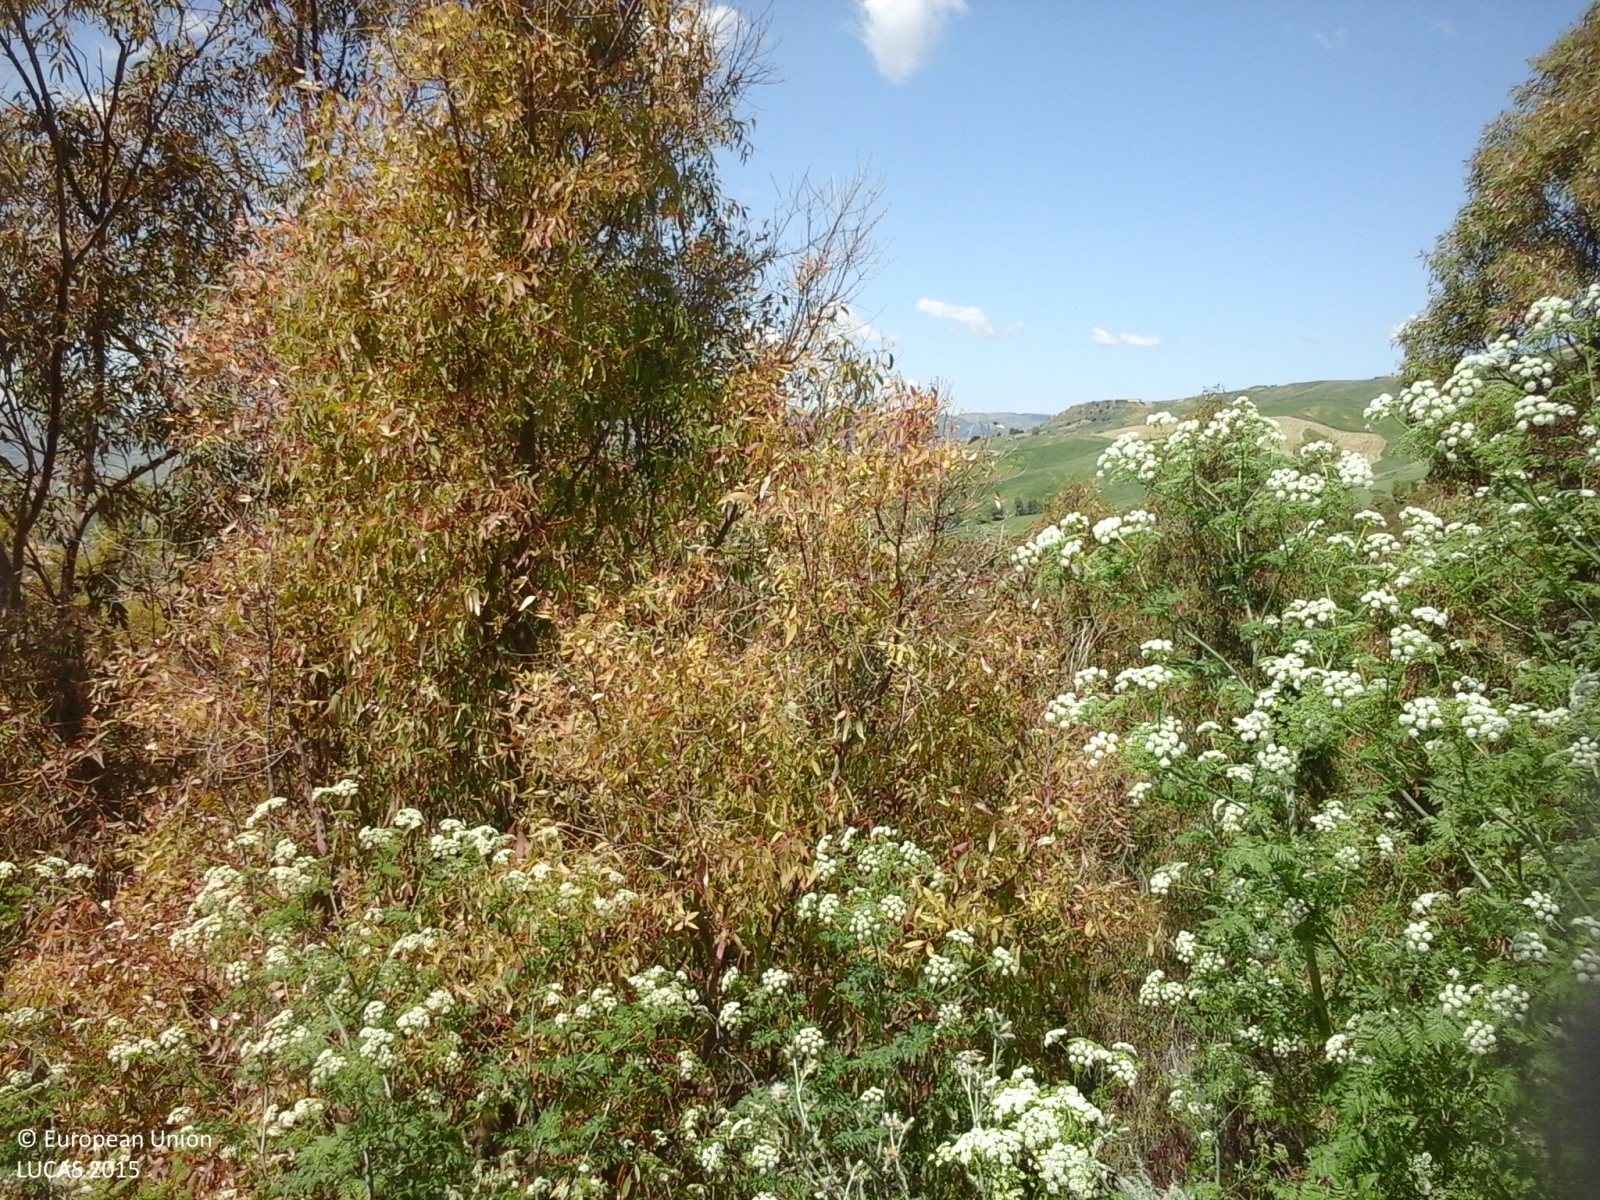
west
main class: Woodland
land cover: Broadleaved woodland
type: coniferous forest of the mediterranean region
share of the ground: > 75 %
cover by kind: broadleaved forest trees 75 %, coniferous forest trees 25 %
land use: Forestry
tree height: > 5 m
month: May
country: IT
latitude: 37.6374
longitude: 13.7459
